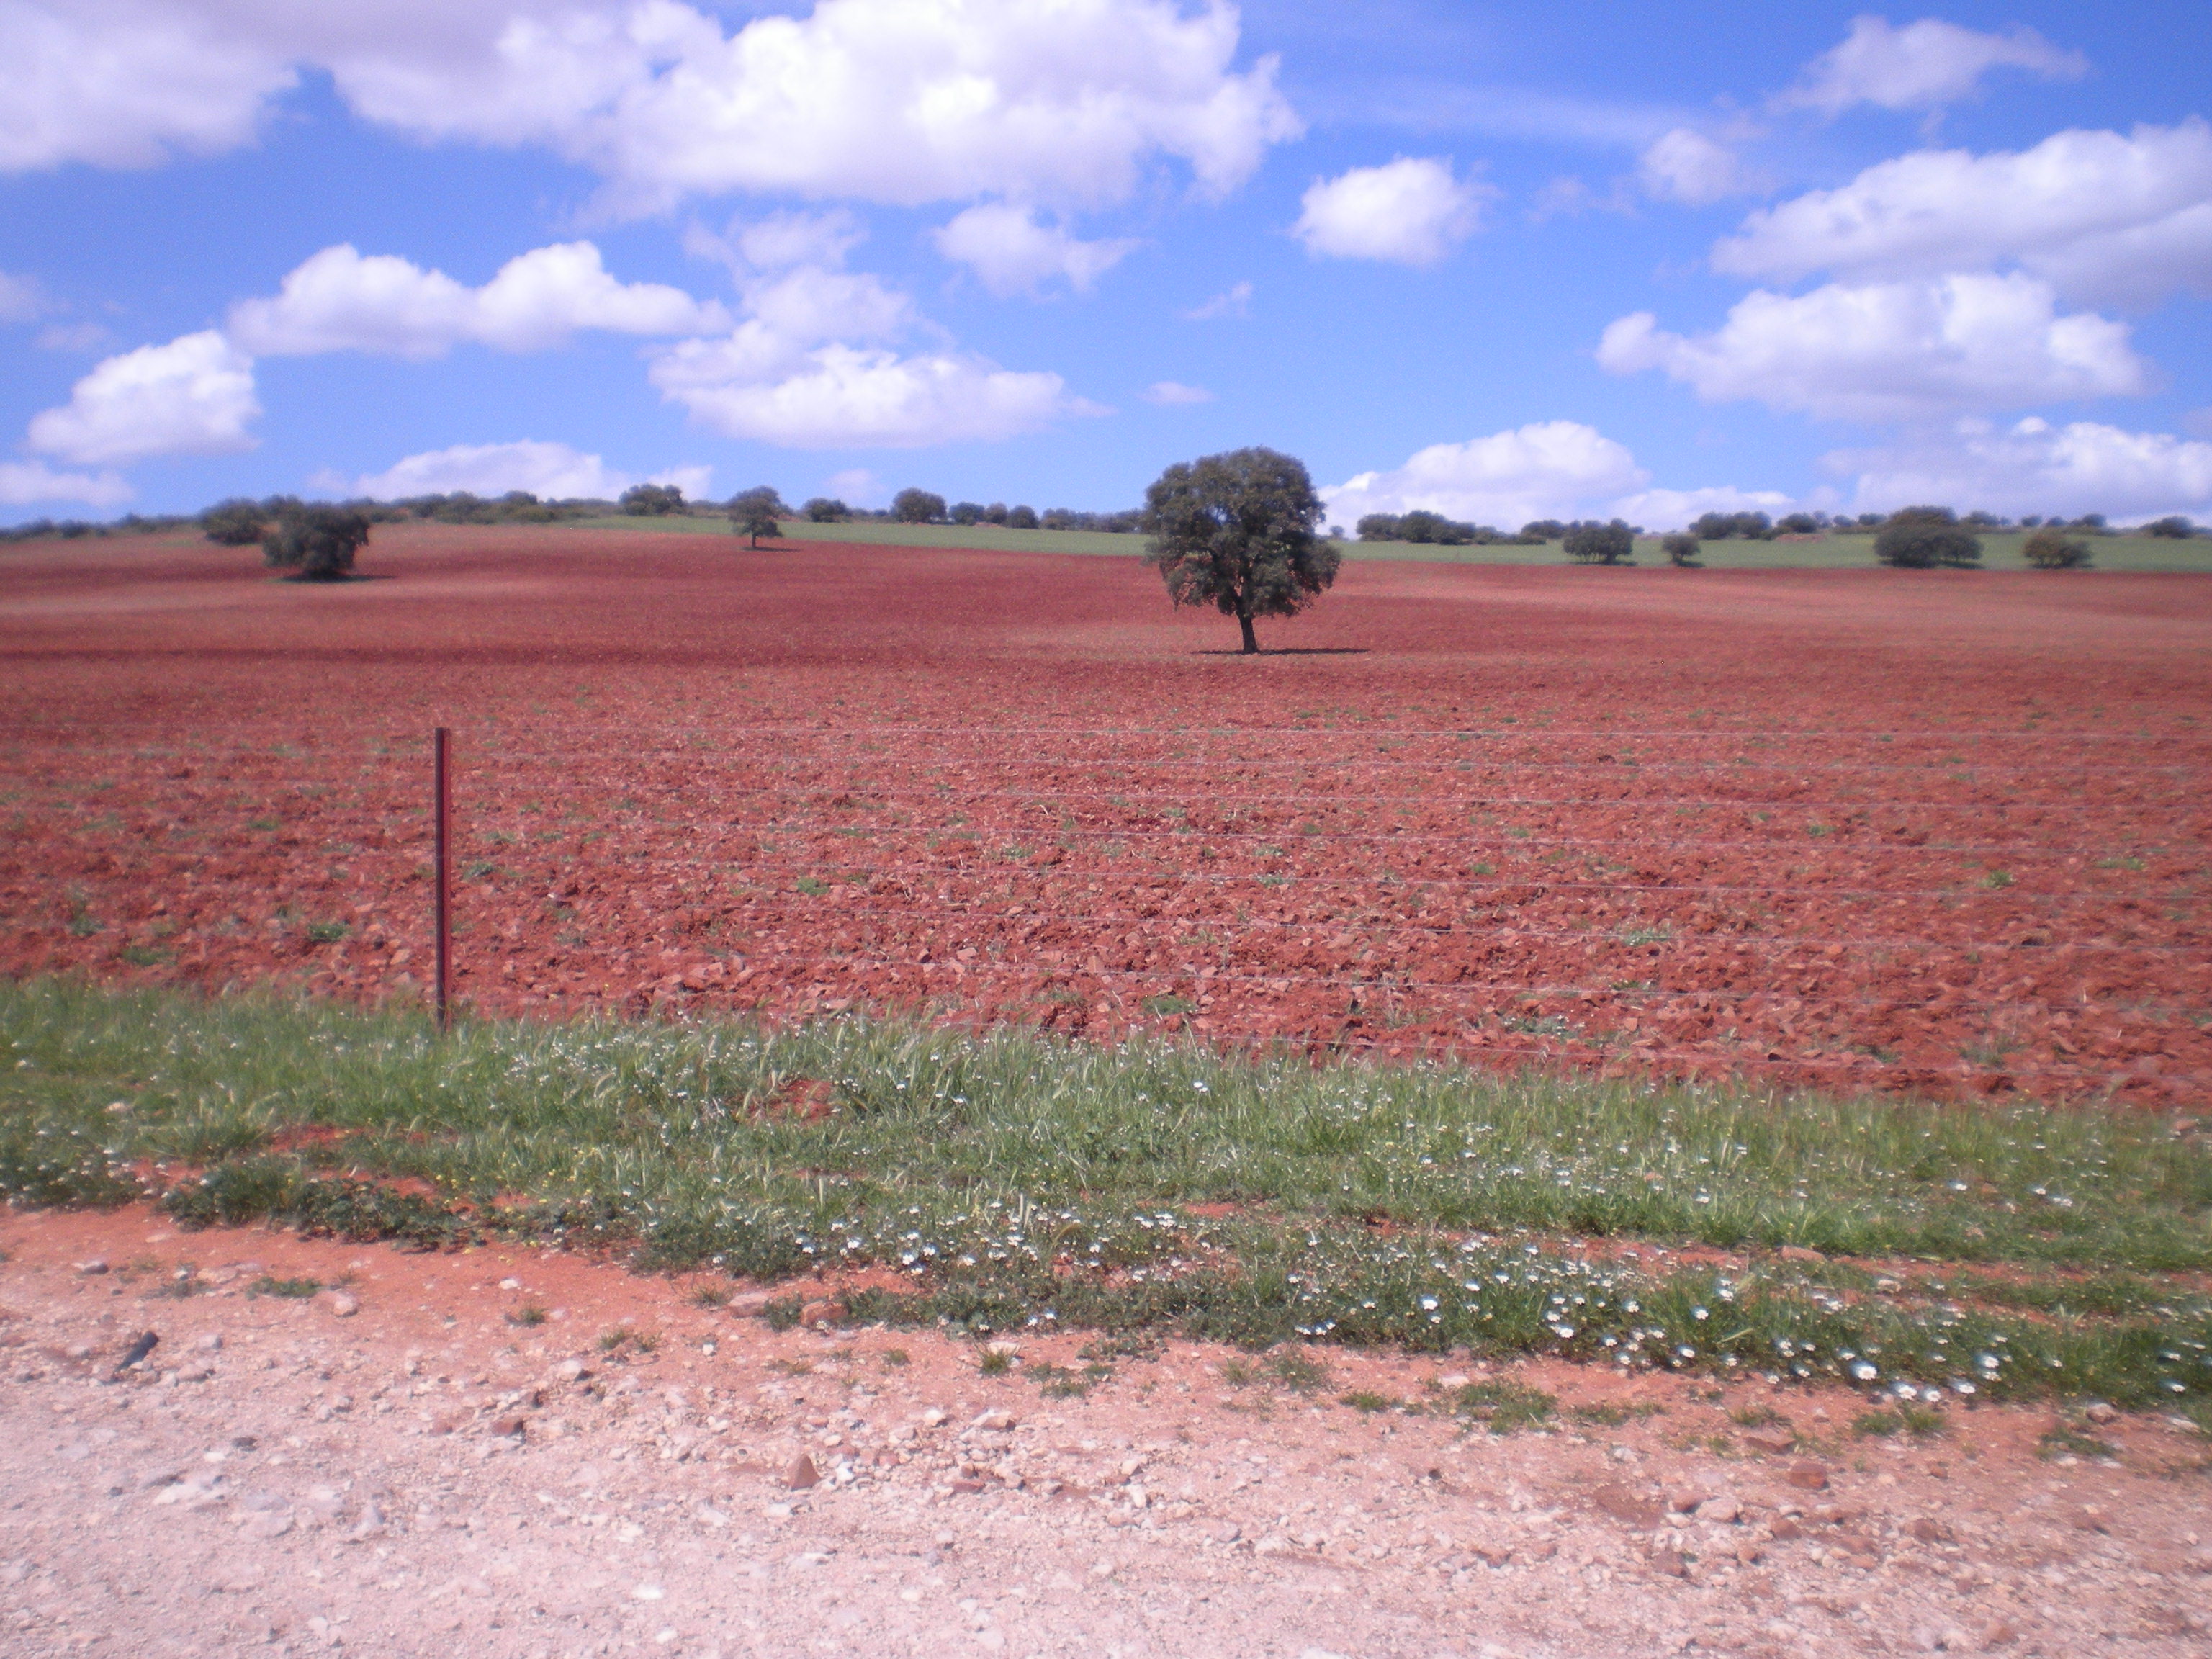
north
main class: Cropland
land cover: Common wheat
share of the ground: > 75 %
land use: Agriculture (excluding fallow land and kitchen gardens)
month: April
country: ES
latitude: 38.7503
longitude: -3.5789
